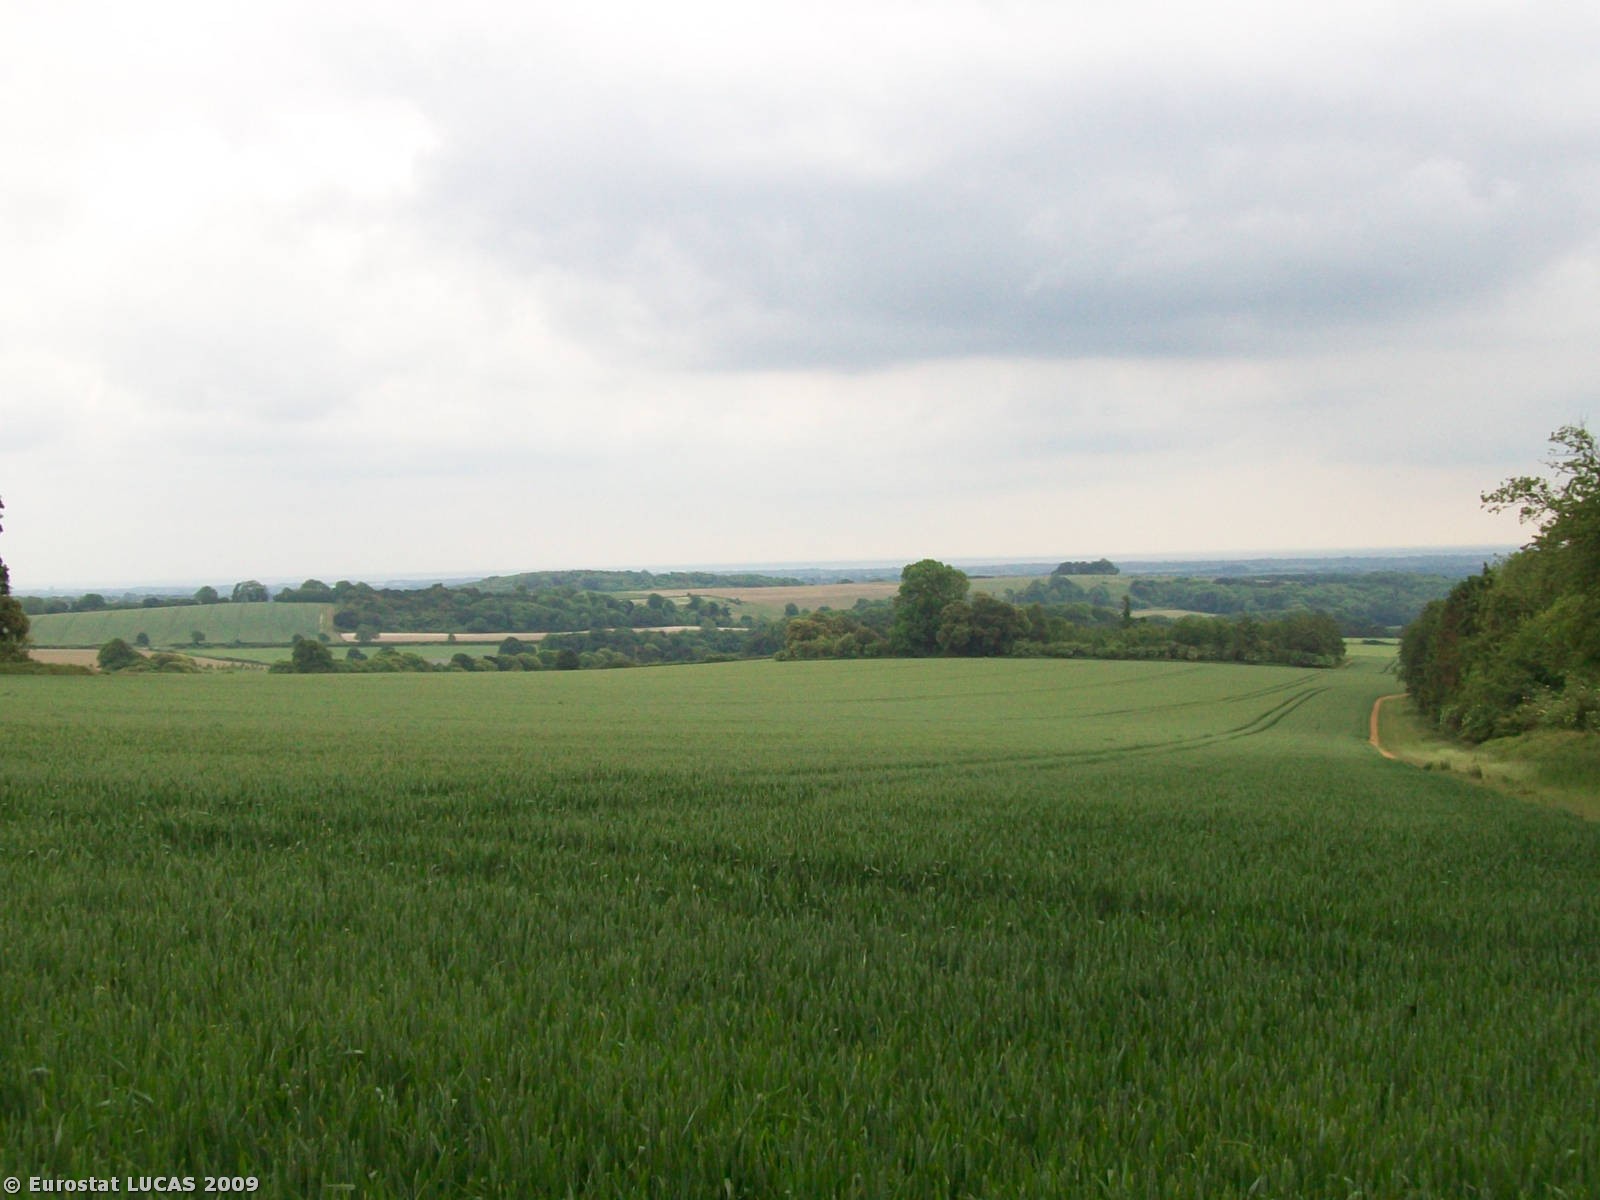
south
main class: Cropland
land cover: Common wheat
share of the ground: > 75 %
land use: Agriculture (excluding fallow land and kitchen gardens)
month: June
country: GB
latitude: 50.8956
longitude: -0.6896
